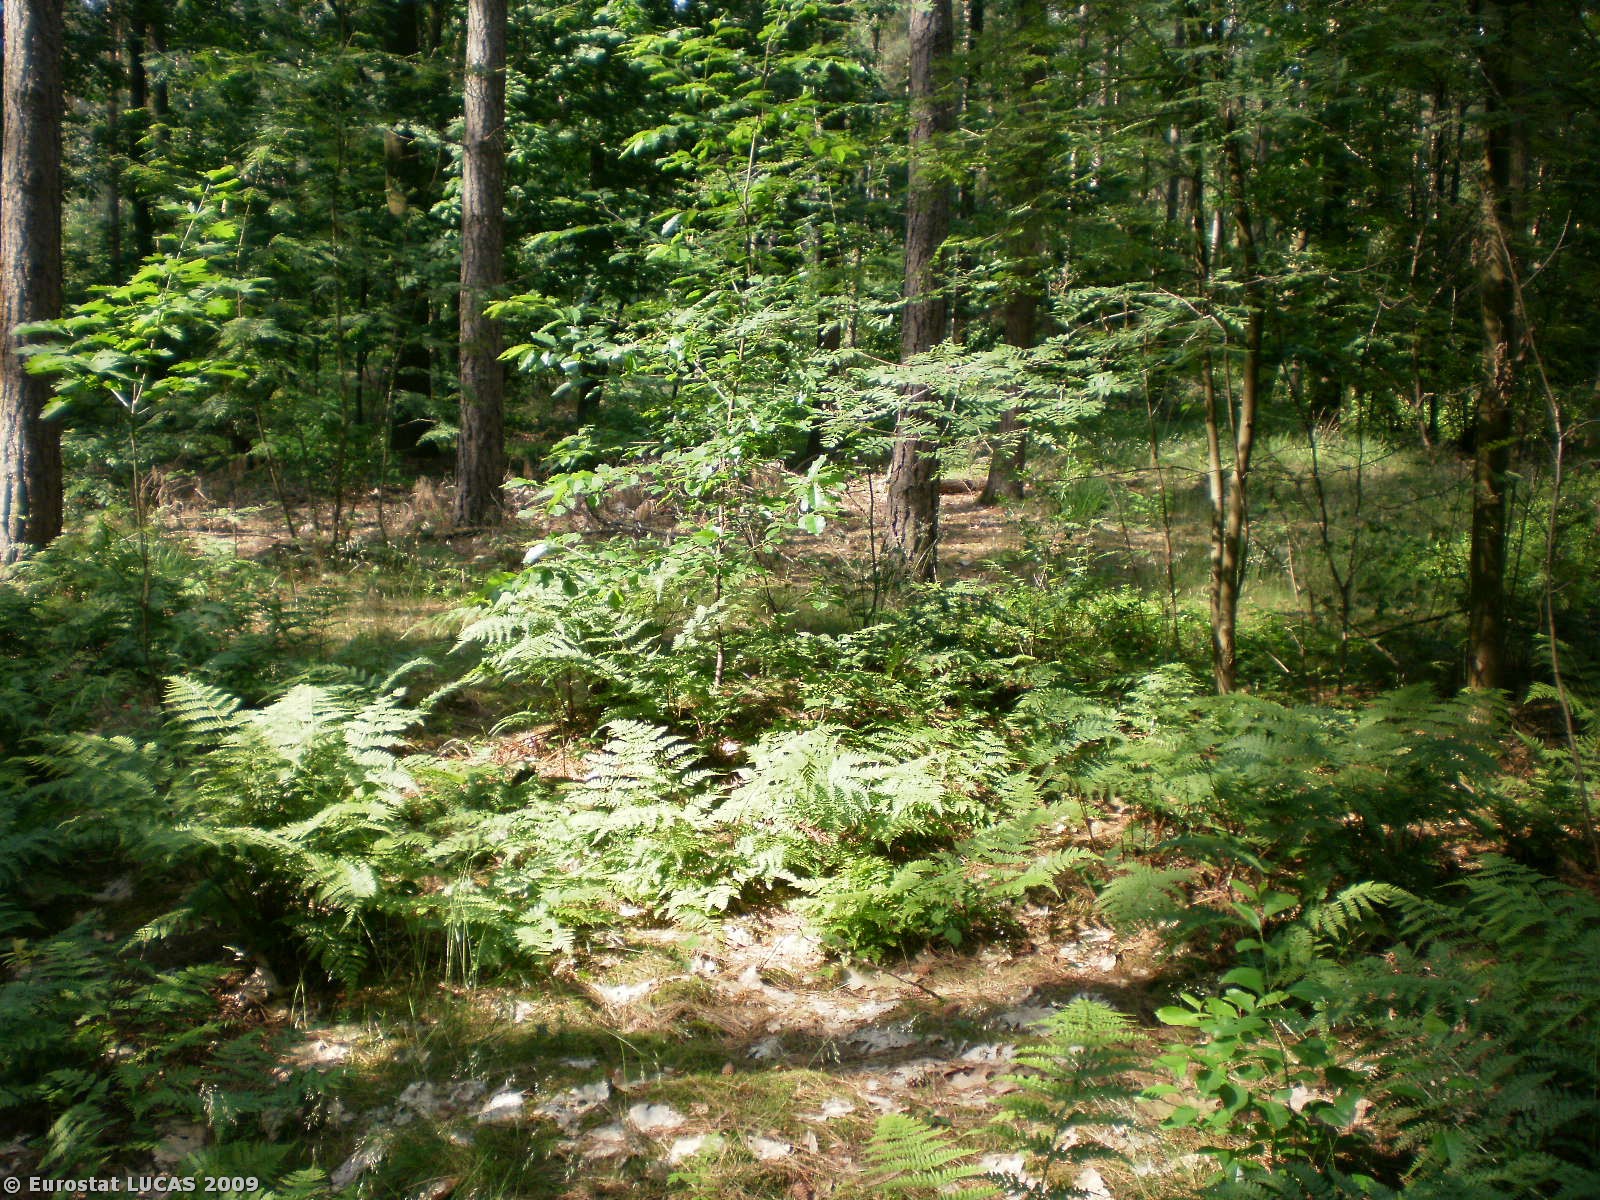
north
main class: Woodland
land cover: Mixed woodland
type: hemiboreal forest and nemoral coniferous forest and mixed broadleaved-coniferous forest
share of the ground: > 75 %
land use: Nature reserves
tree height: > 5 m
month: June
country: BE
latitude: 51.0299
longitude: 5.4495
